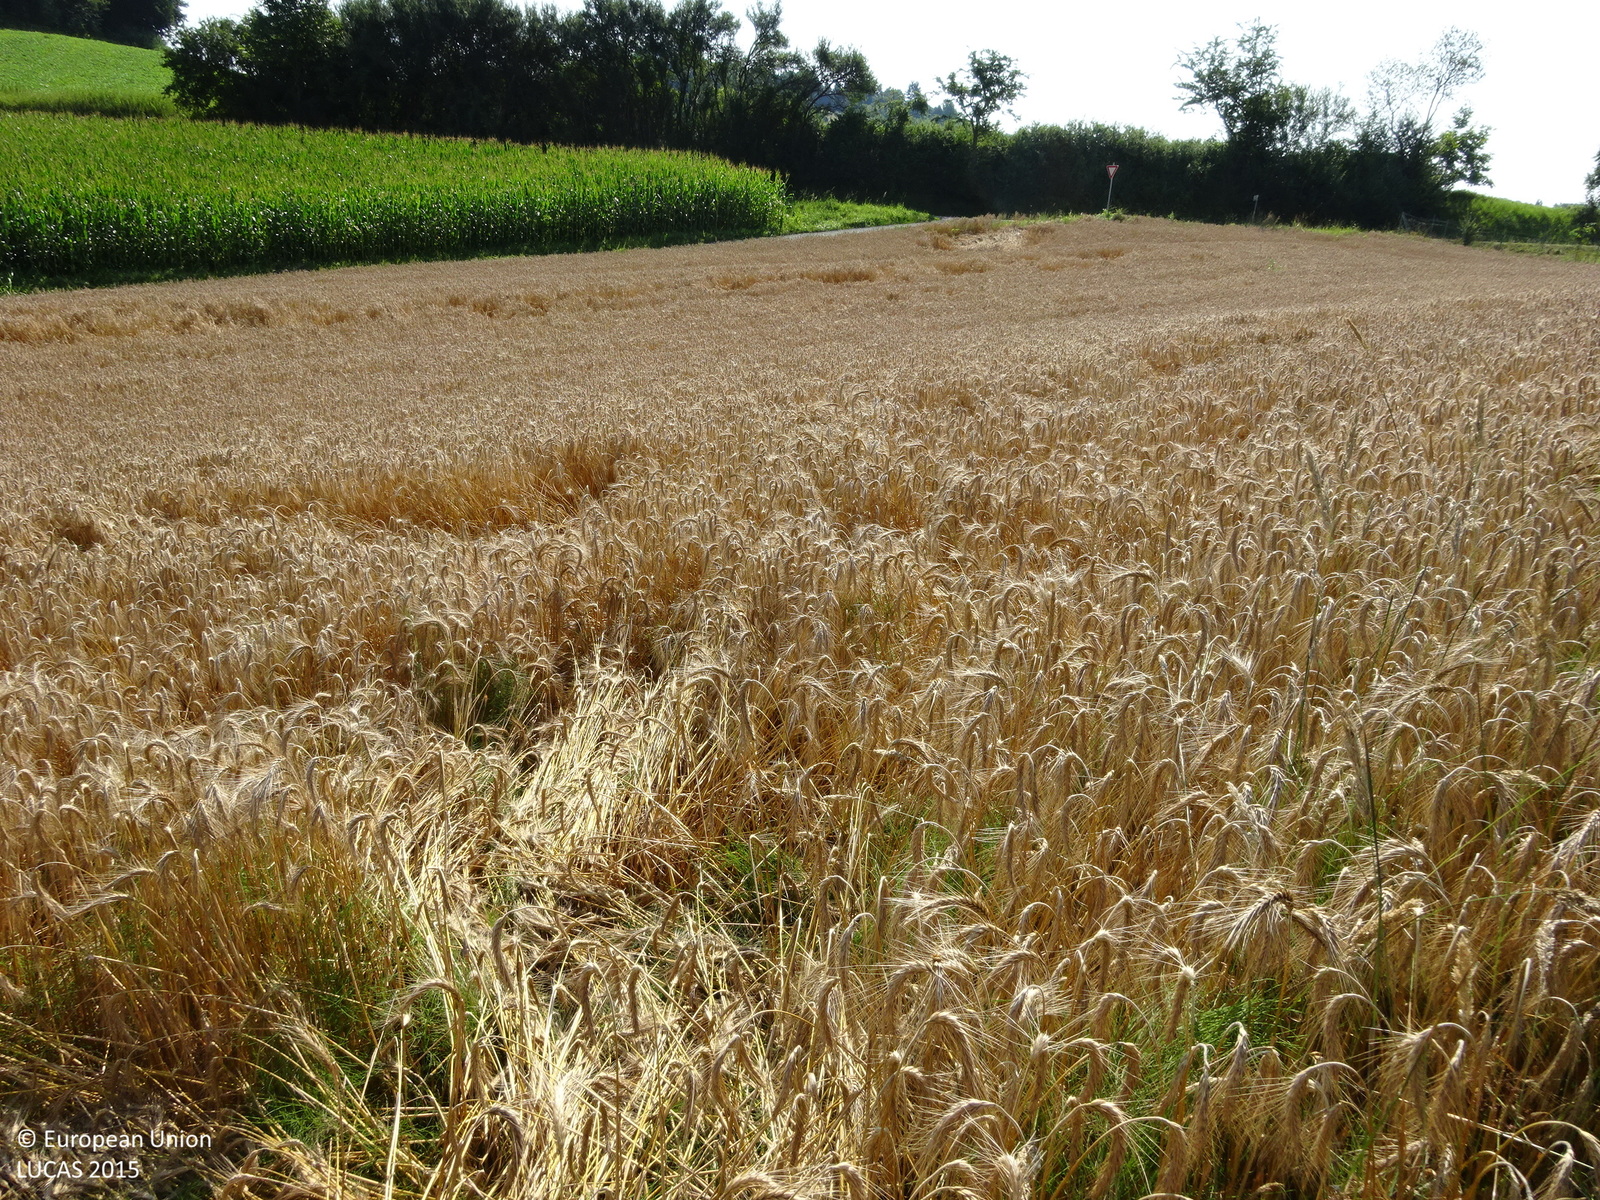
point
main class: Cropland
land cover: Barley
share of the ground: > 75 %
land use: Agriculture (excluding fallow land and kitchen gardens)
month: July
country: AT
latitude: 46.8252
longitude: 15.4656
